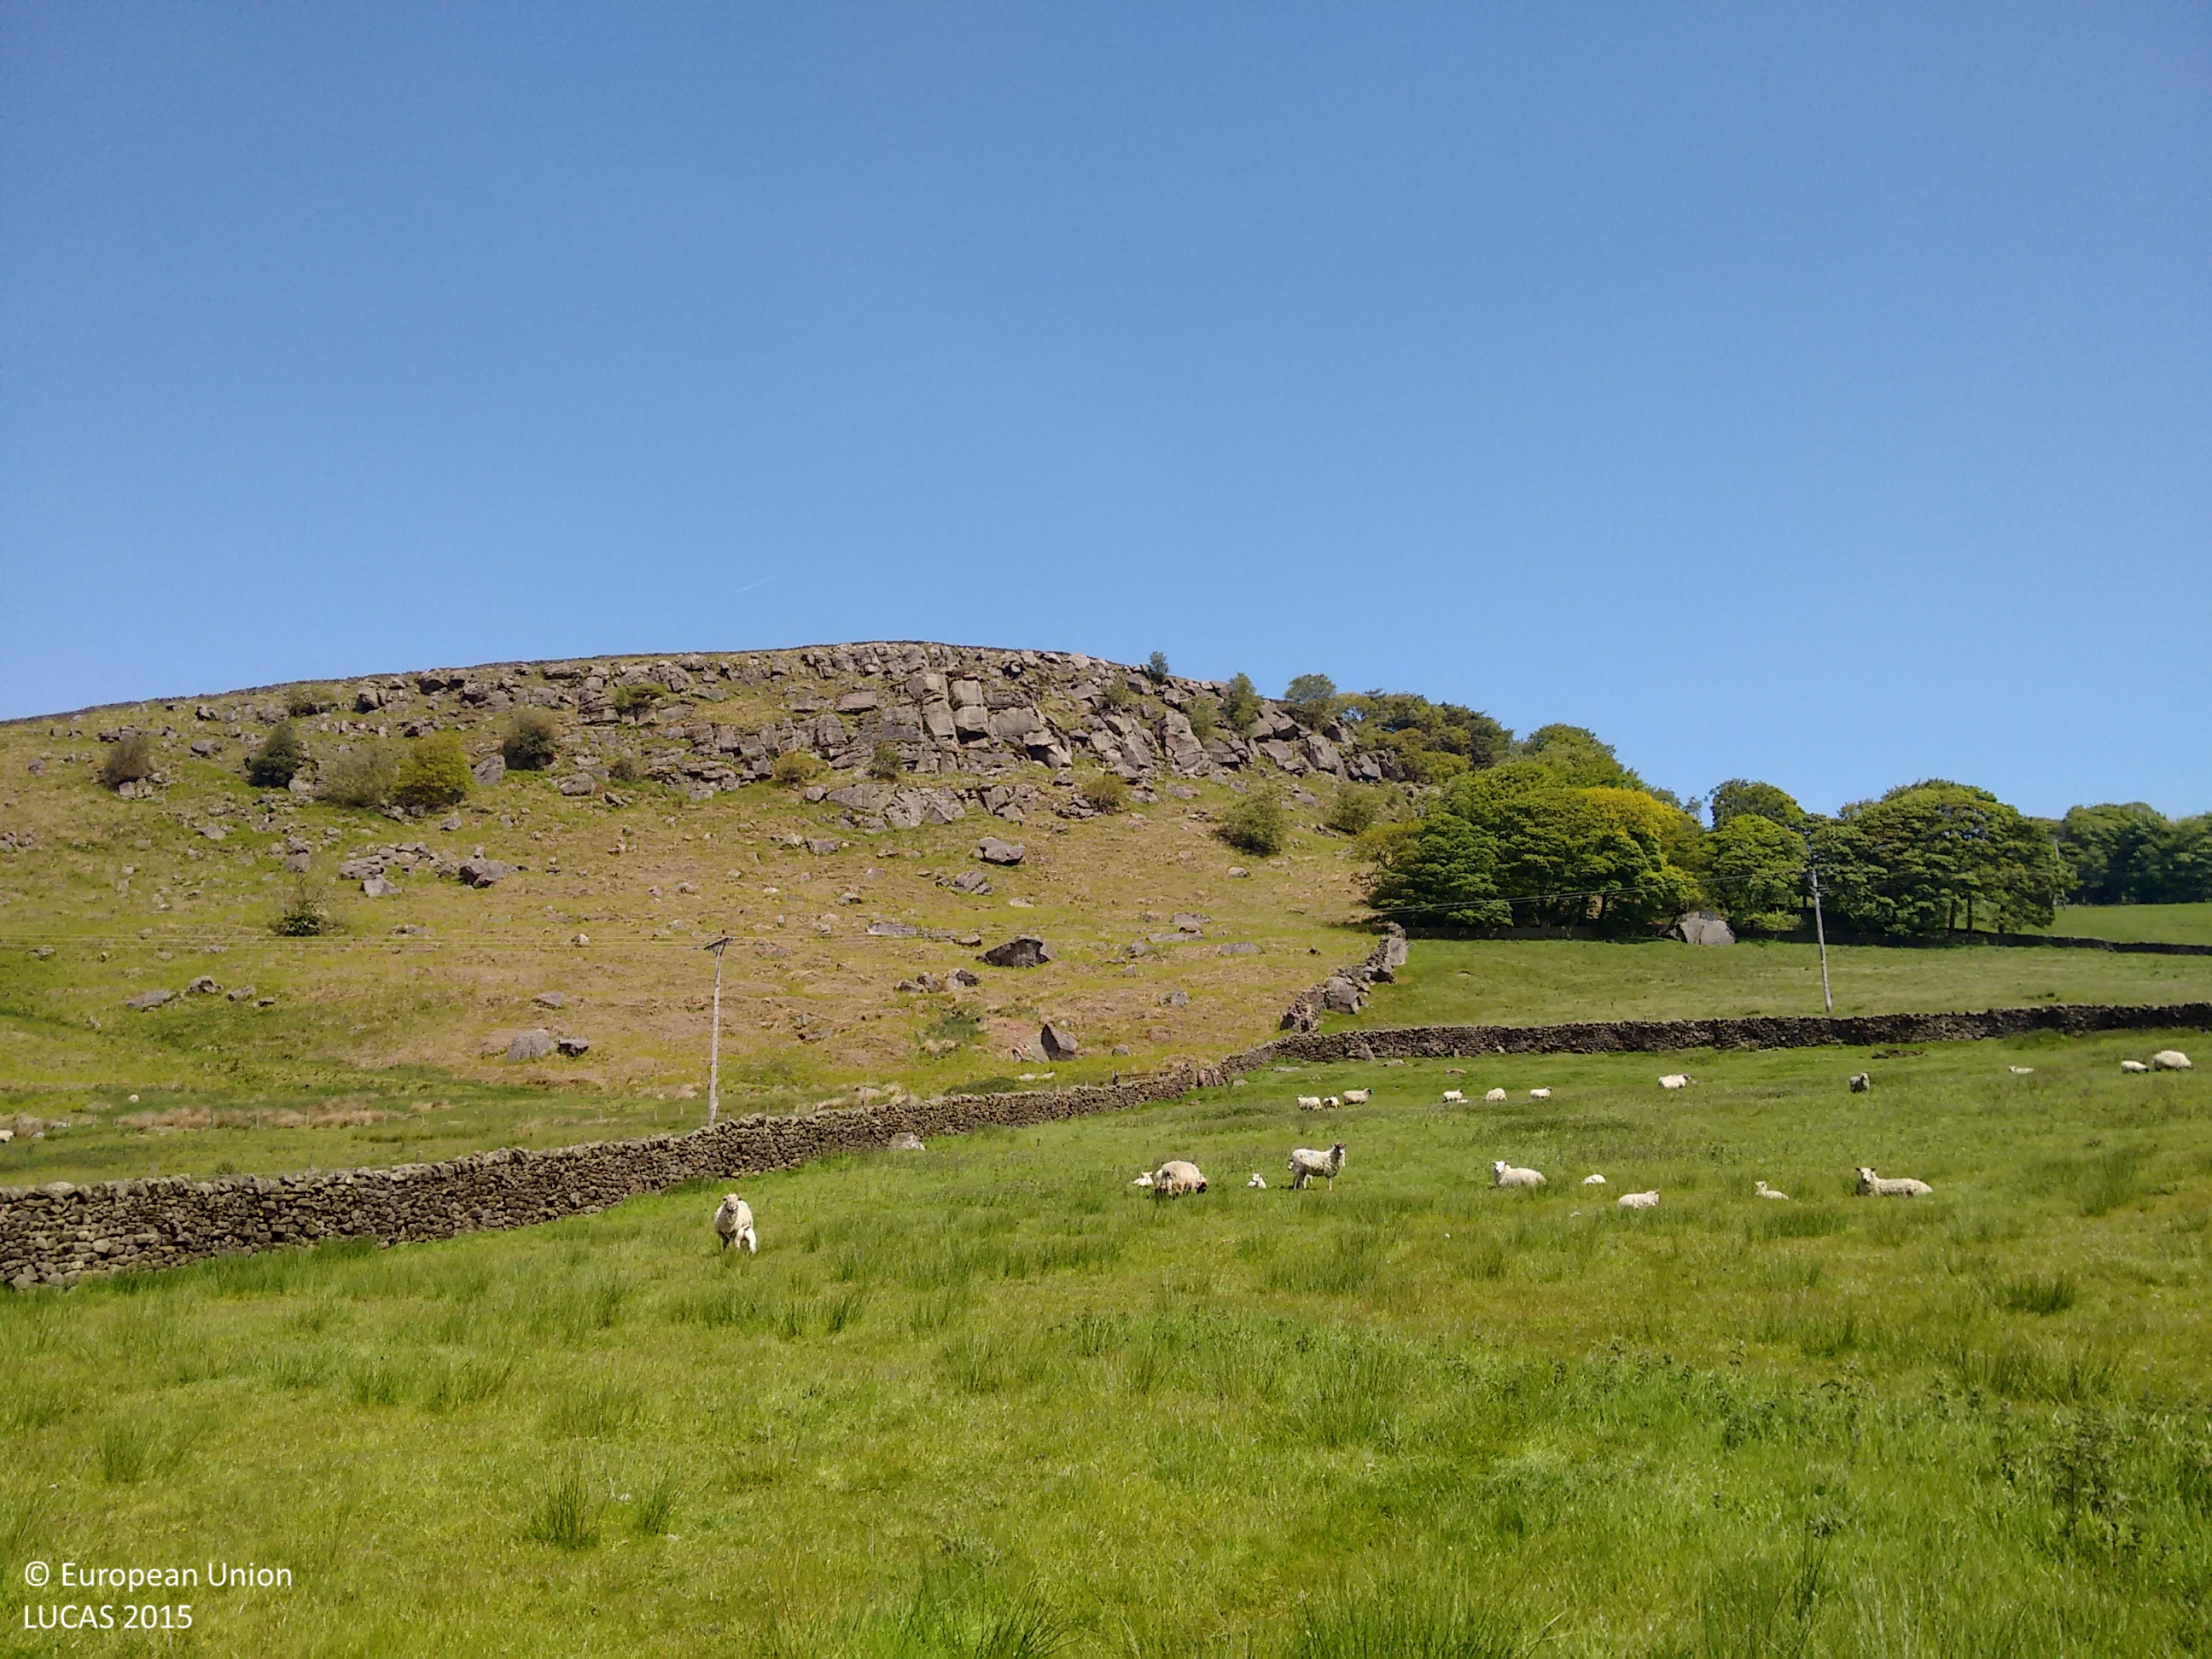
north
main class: Grassland
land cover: Grassland without tree/shrub cover
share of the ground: > 75 %
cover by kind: herbaceous plants 100 %
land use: Agriculture (excluding fallow land and kitchen gardens)
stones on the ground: < 10 %
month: June
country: GB
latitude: 53.9880
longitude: -1.9675
